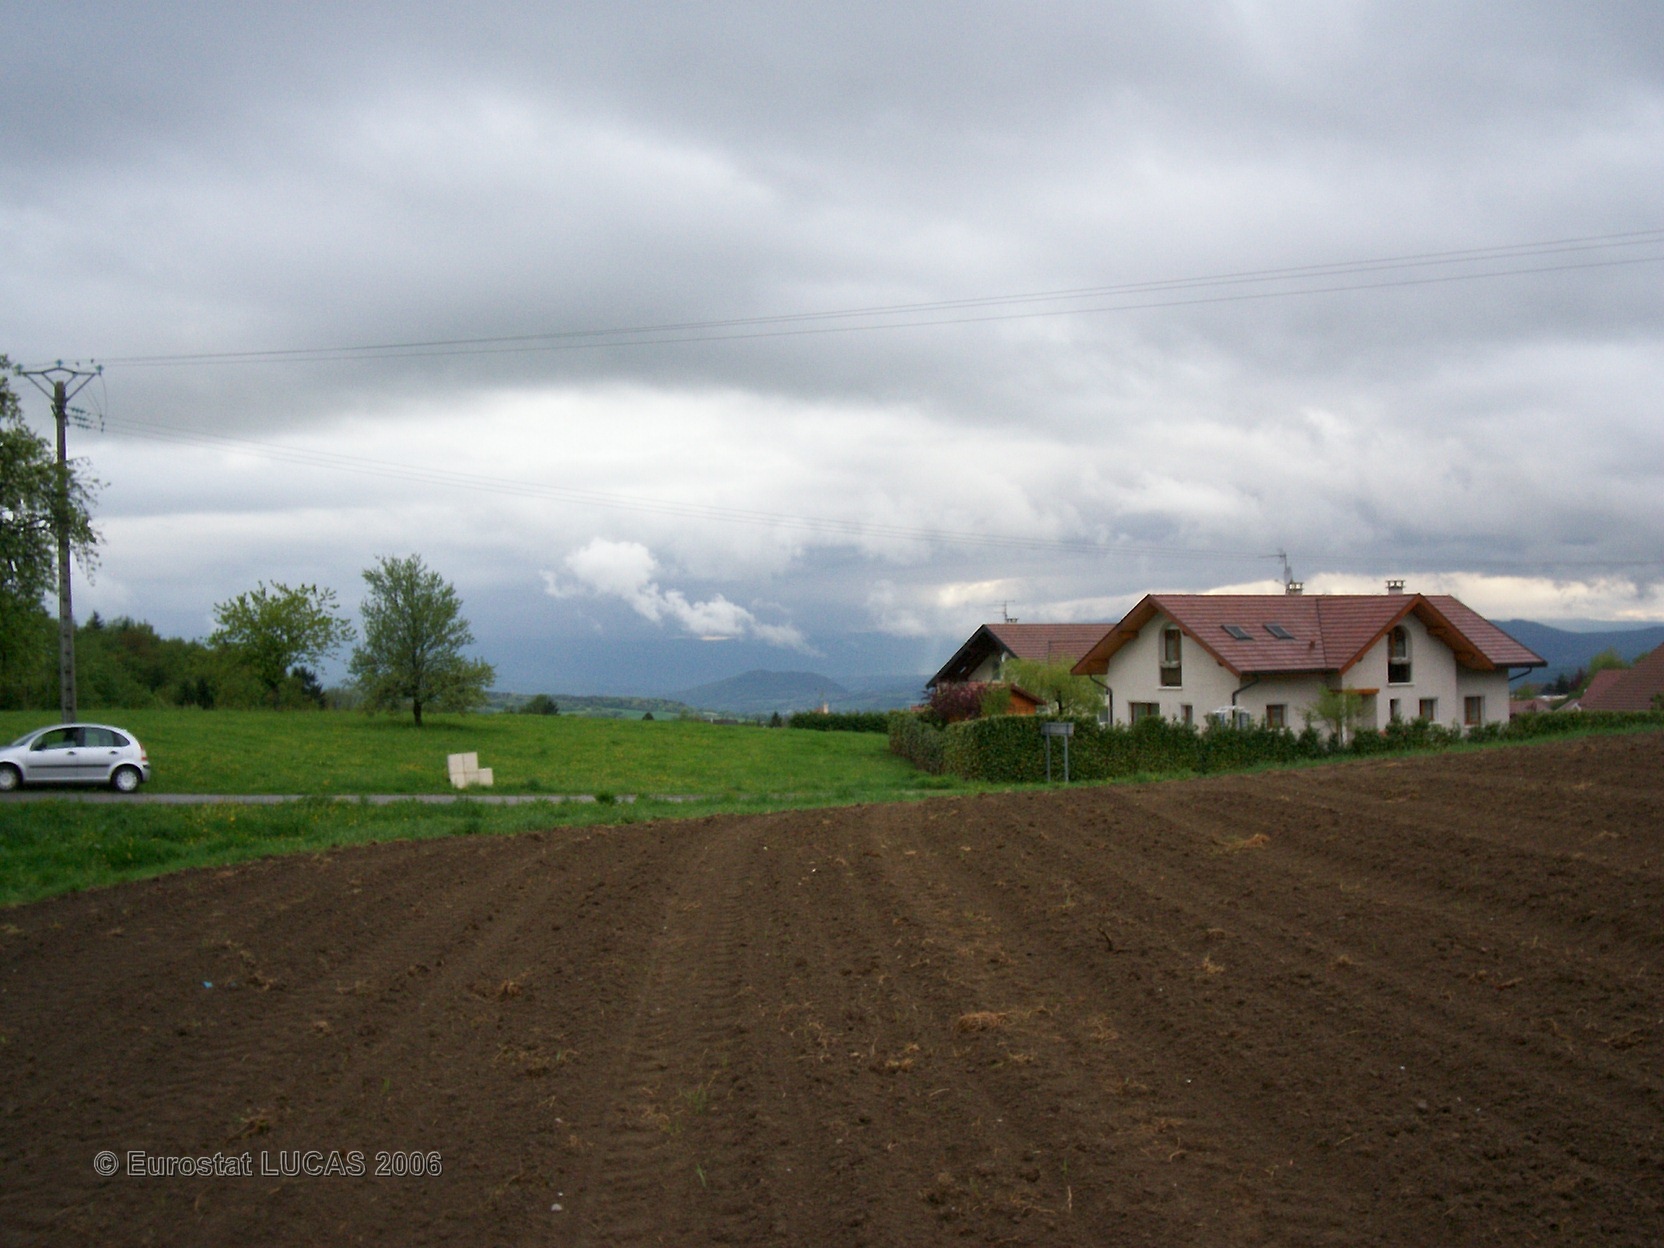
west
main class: Cropland
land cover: Maize
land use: Agriculture (excluding fallow land and kitchen gardens)
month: May
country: FR
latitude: 46.0282
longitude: 6.1151
